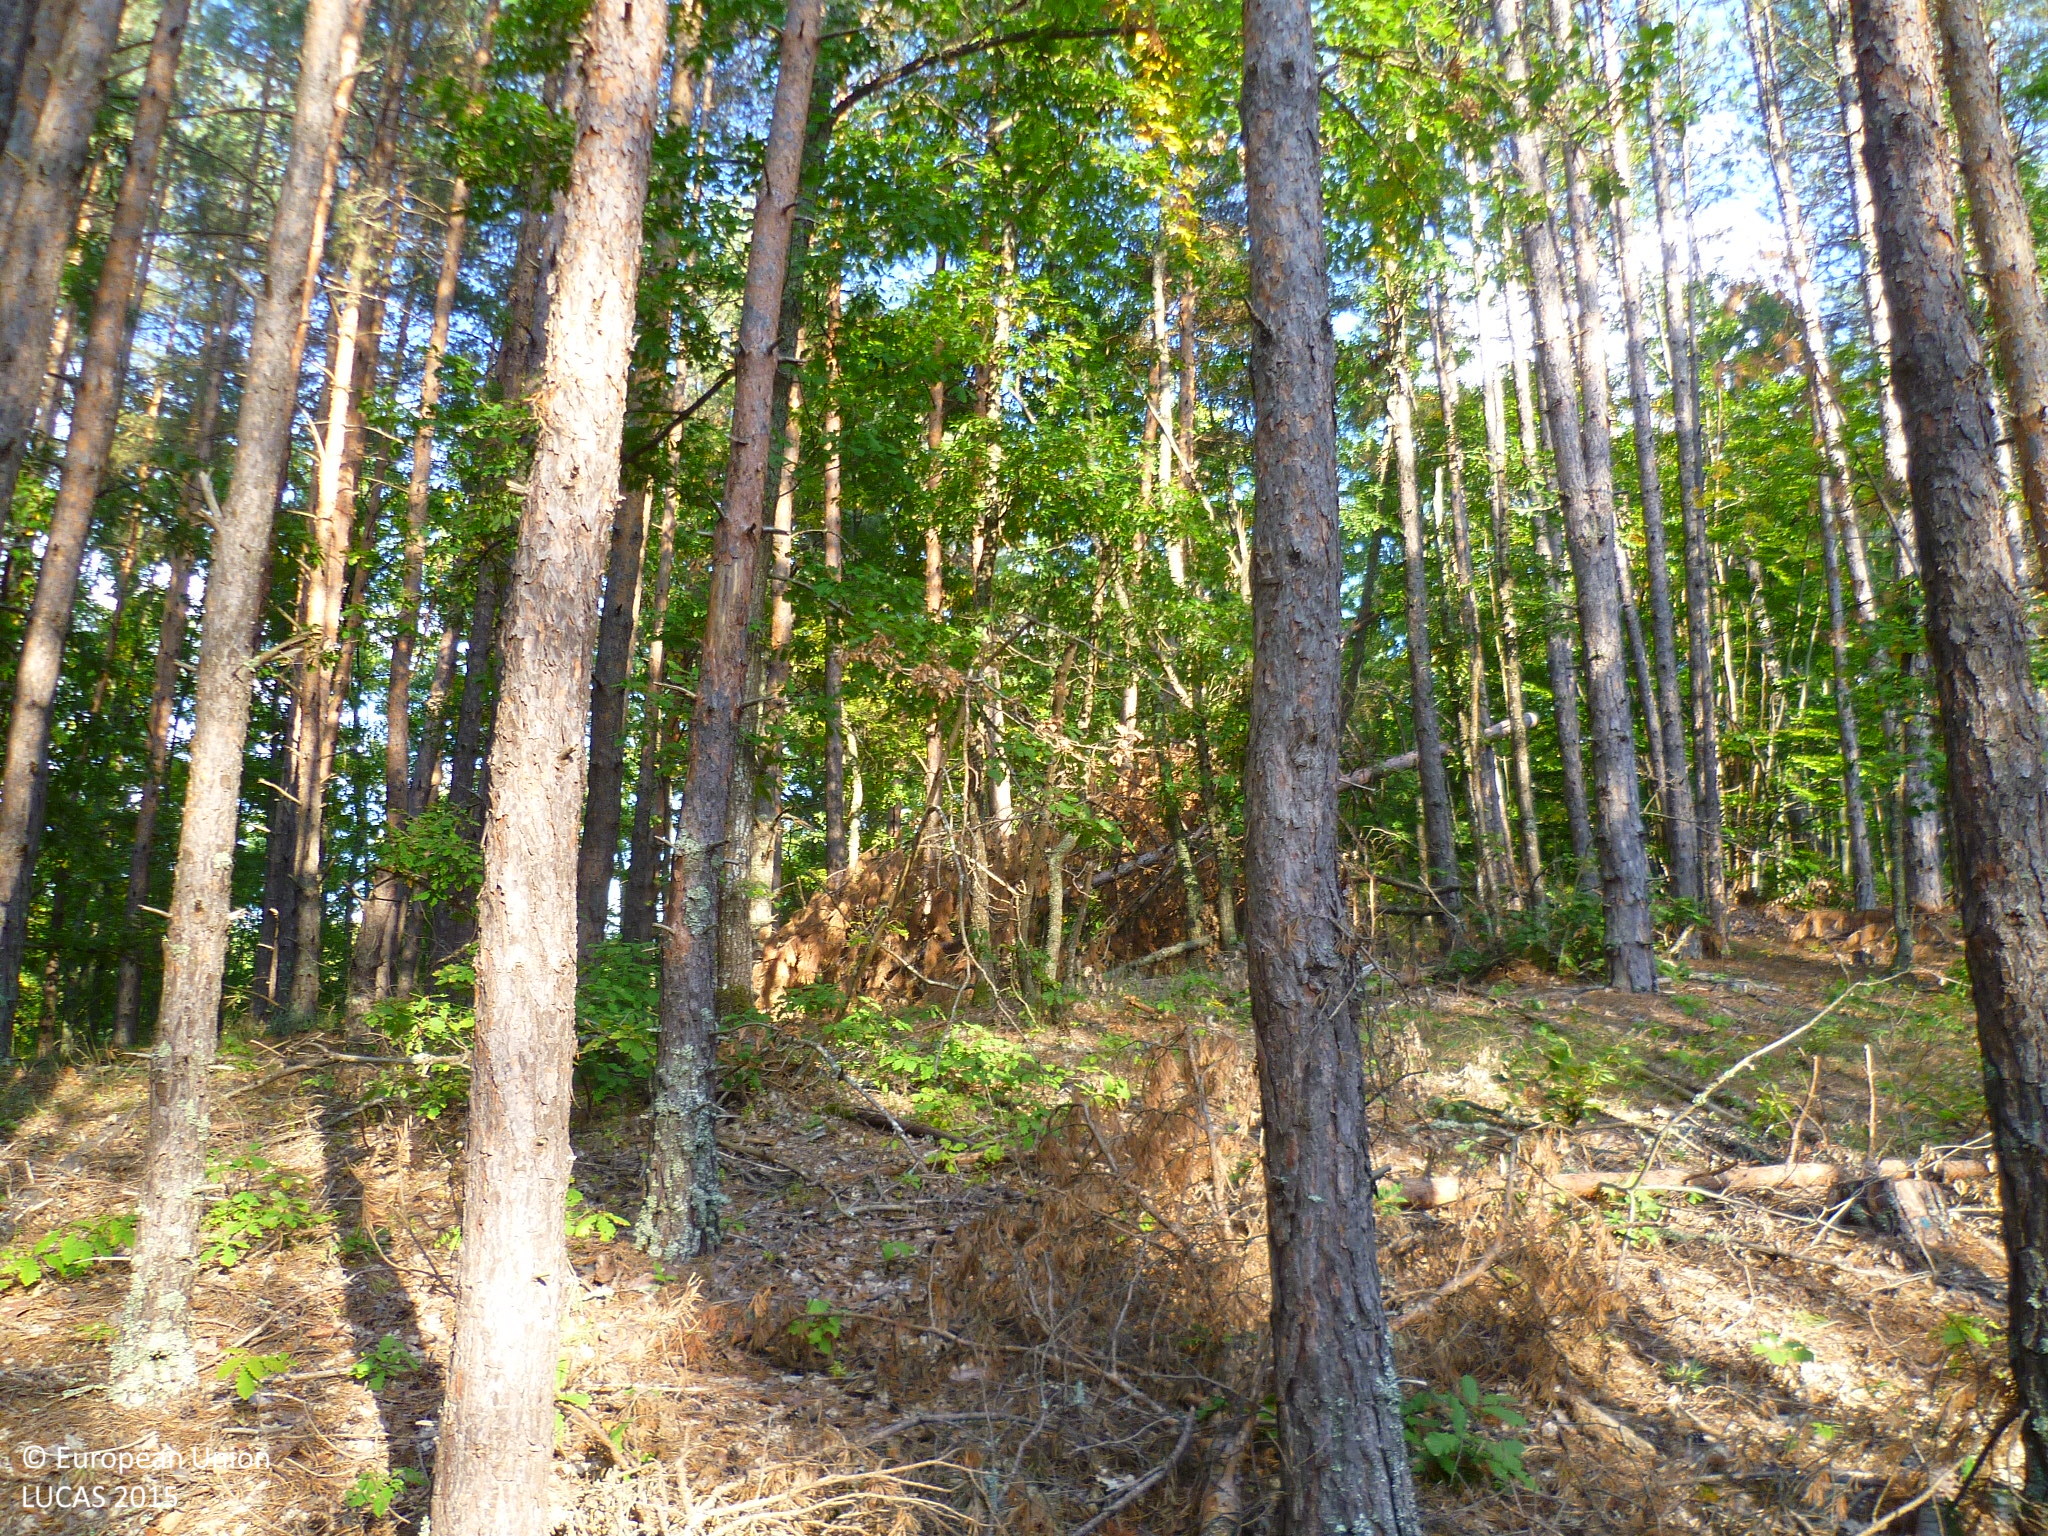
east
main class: Woodland
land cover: Pine dominated mixed woodland
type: hemiboreal forest and nemoral coniferous forest and mixed broadleaved-coniferous forest
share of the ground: > 75 %
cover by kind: coniferous forest trees 60 %, broadleaved forest trees 20 %, unconsolidated bare surface 15 %, herbaceous plants 5 %
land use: Forestry
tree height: > 5 m
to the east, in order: Pine dominated mixed woodland; Tracks; Pine dominated mixed woodland
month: October
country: BG
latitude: 42.7848
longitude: 22.6783
